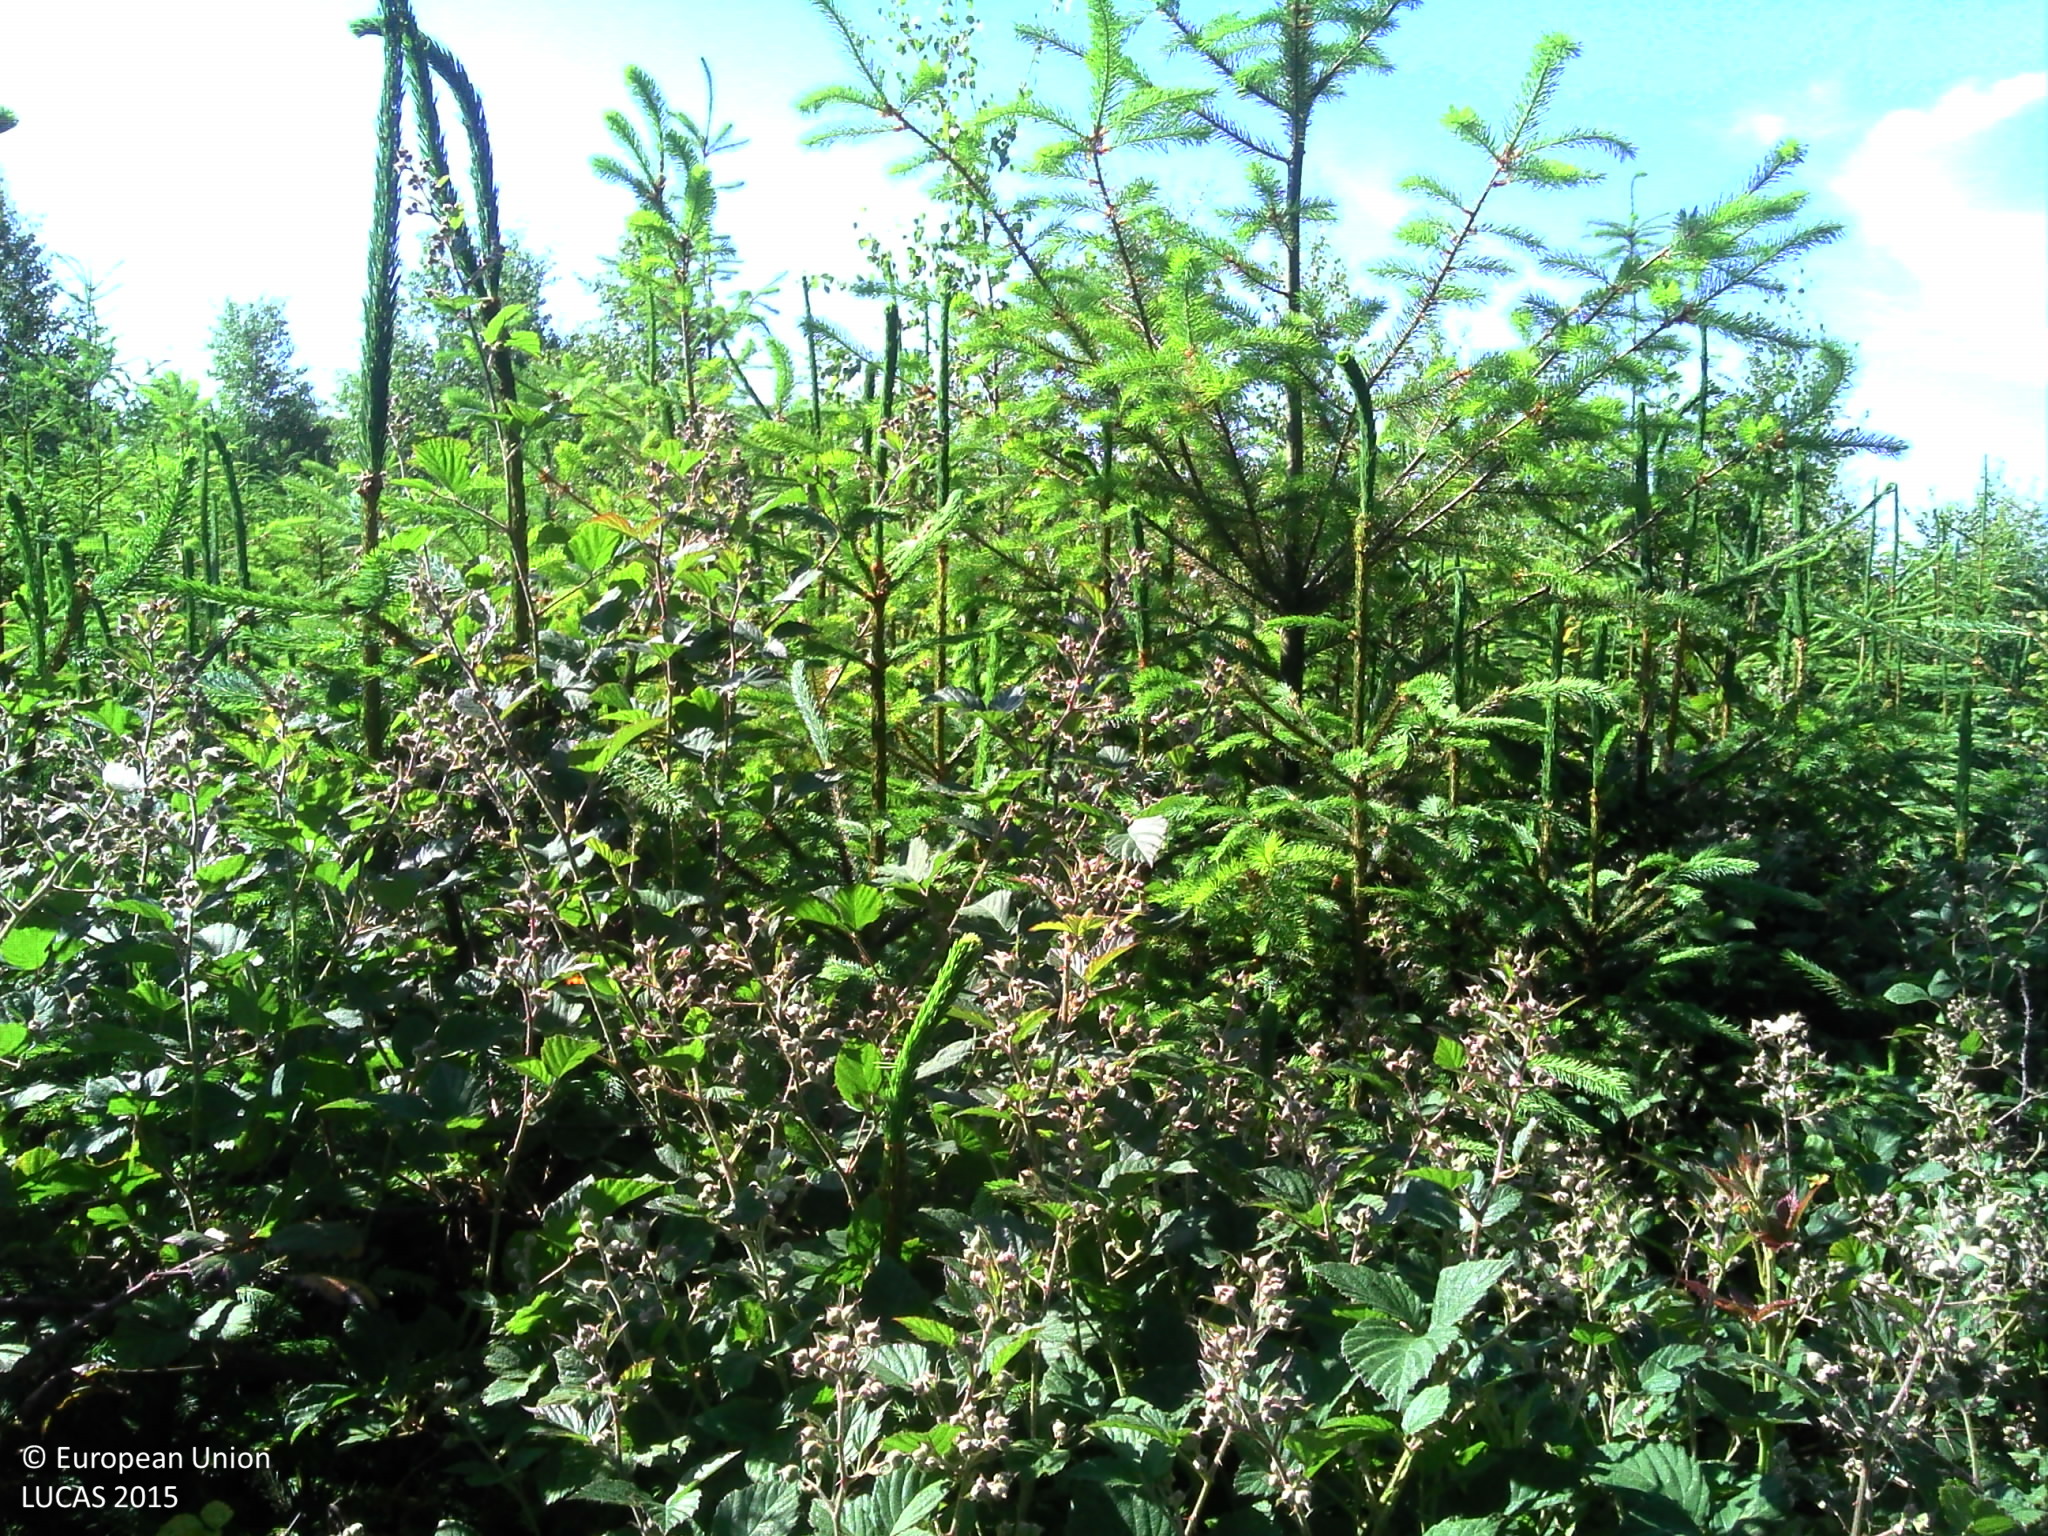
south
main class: Woodland
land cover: Other mixed woodland
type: acidophilous oak and oak-birch forest
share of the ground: 10 - 25 %
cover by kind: shrubs 50 %, herbaceous plants 30 %, coniferous forest trees 10 %, broadleaved forest trees 10 %
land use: Forestry
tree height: > 5 m
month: June
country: BE
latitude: 50.1968
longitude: 5.3331
